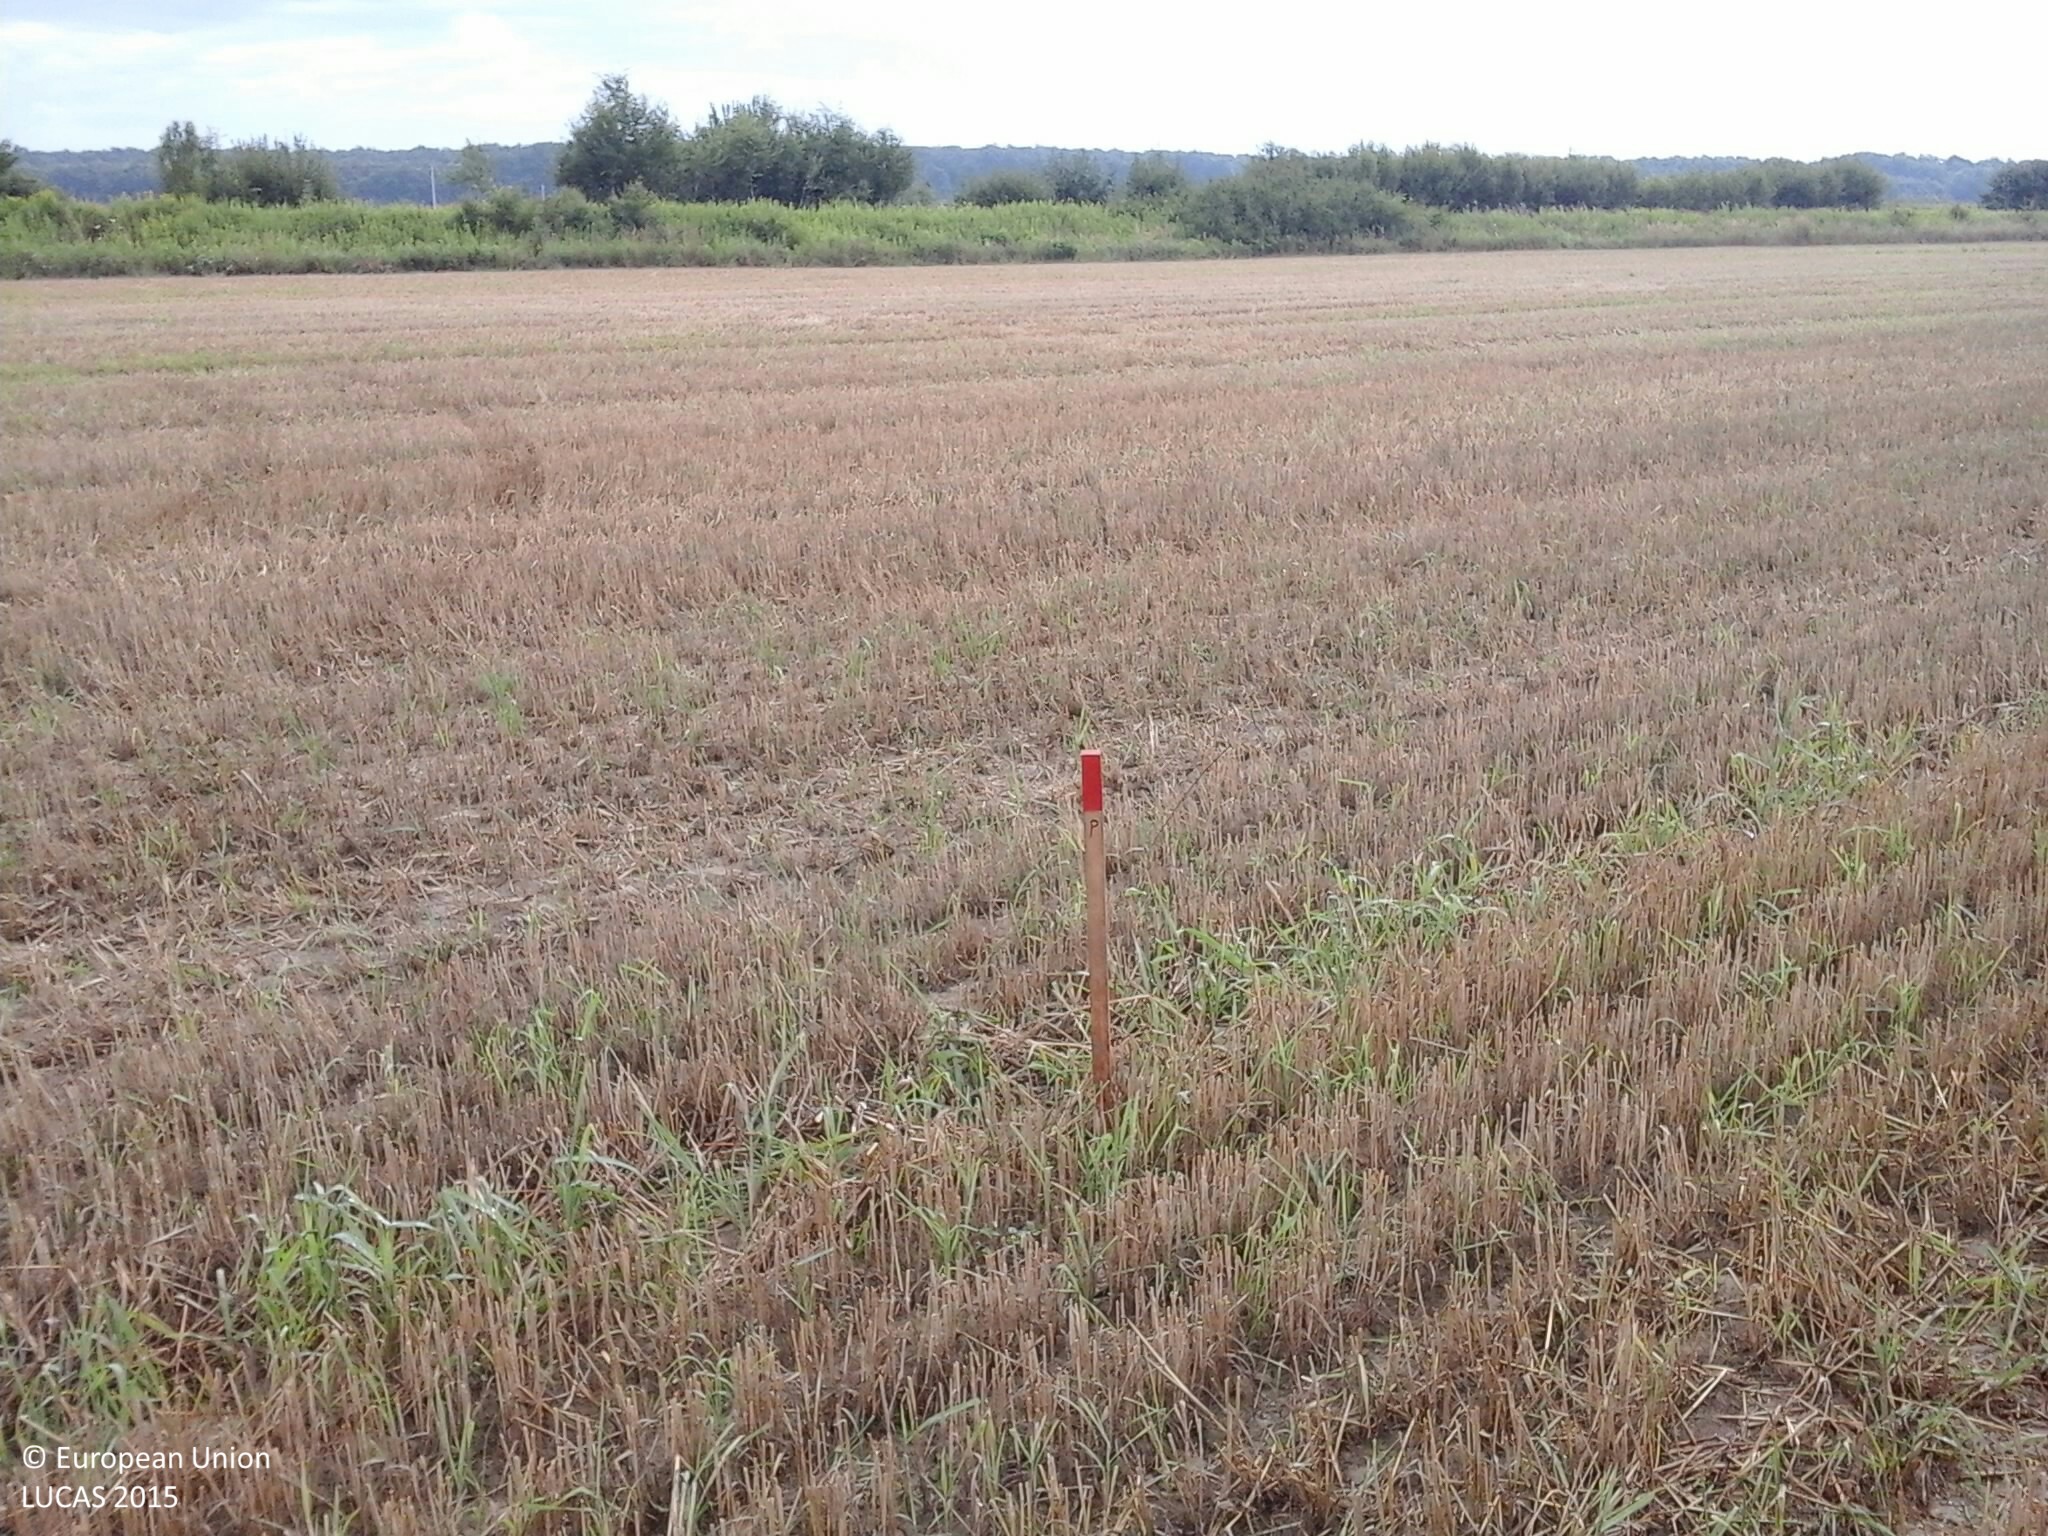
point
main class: Cropland
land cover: Common wheat
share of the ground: 10 - 25 %
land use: Agriculture (excluding fallow land and kitchen gardens)
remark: Harvested field
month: July
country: HU
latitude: 46.6969
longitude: 16.4750
